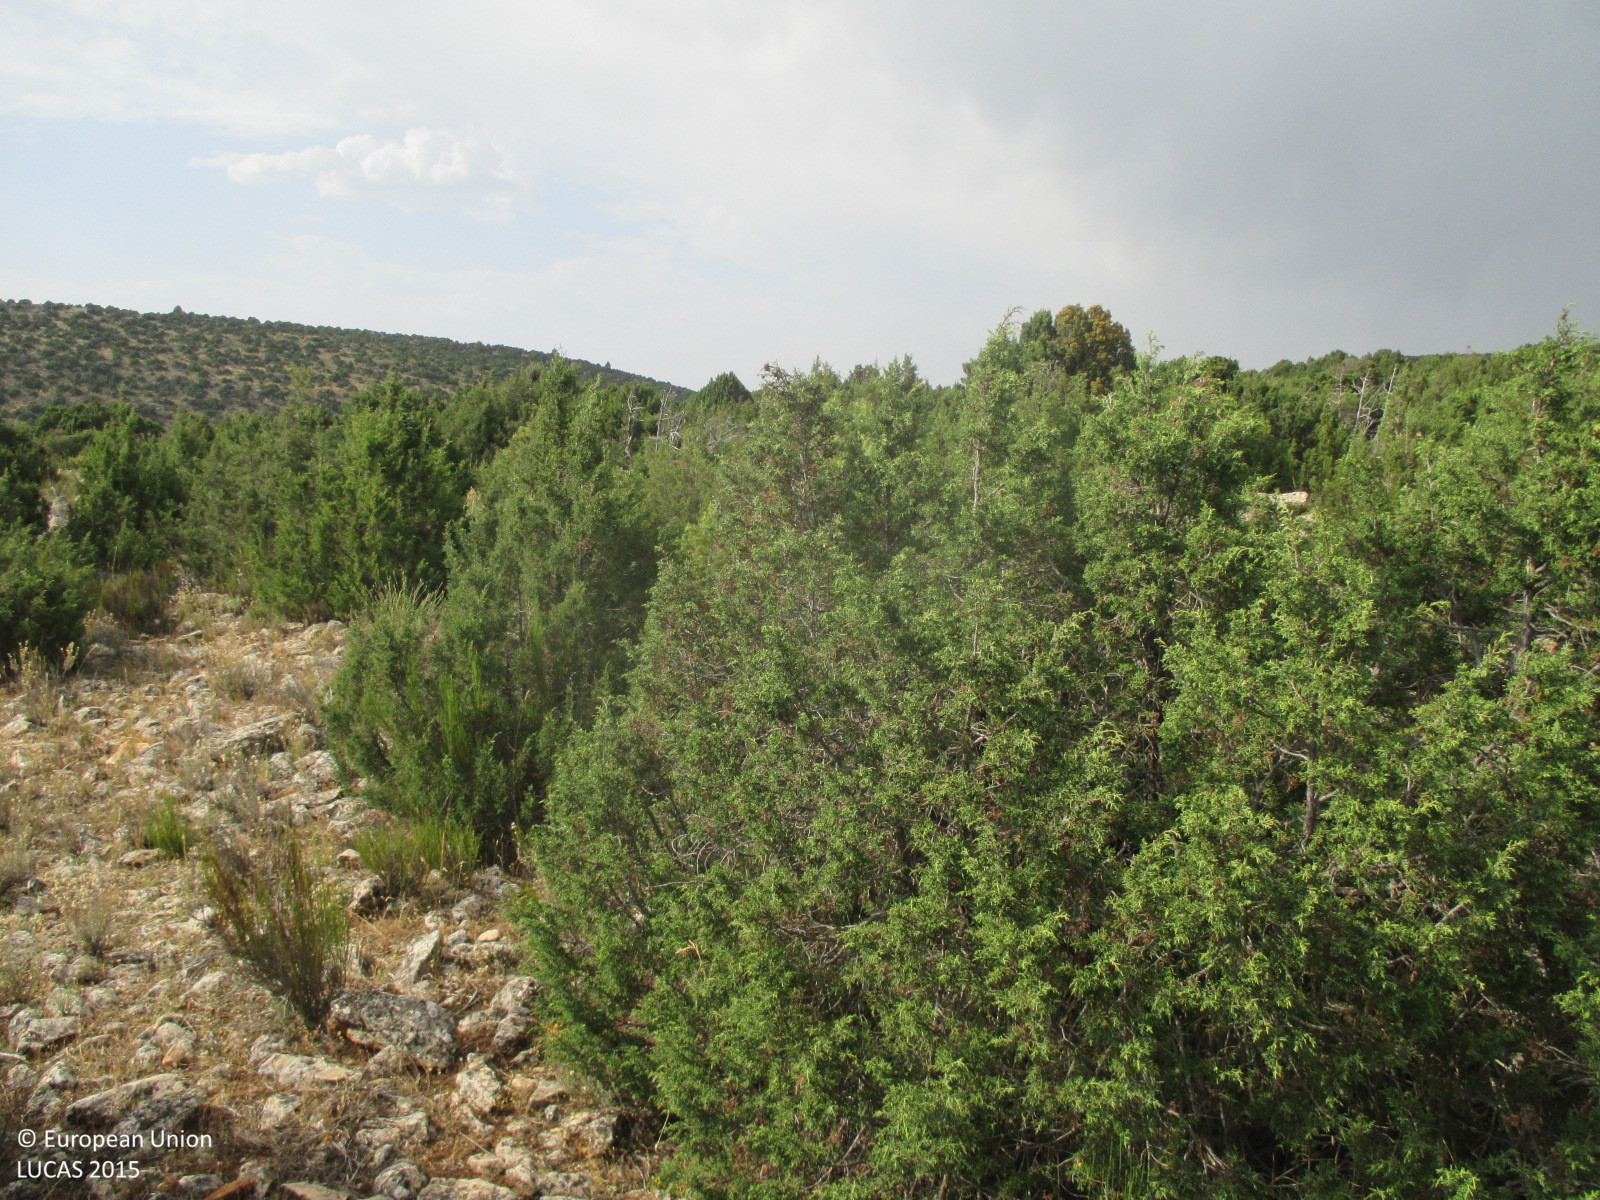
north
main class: Shrubland
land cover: Shrubland without tree cover
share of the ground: 50 - 75 %
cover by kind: shrubs 50 %, herbaceous plants 30 %, consolidated bare surface 20 %
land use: Semi-natural and natural areas not in use
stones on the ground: < 10 %
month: July
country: ES
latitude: 38.1929
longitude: -2.4285
